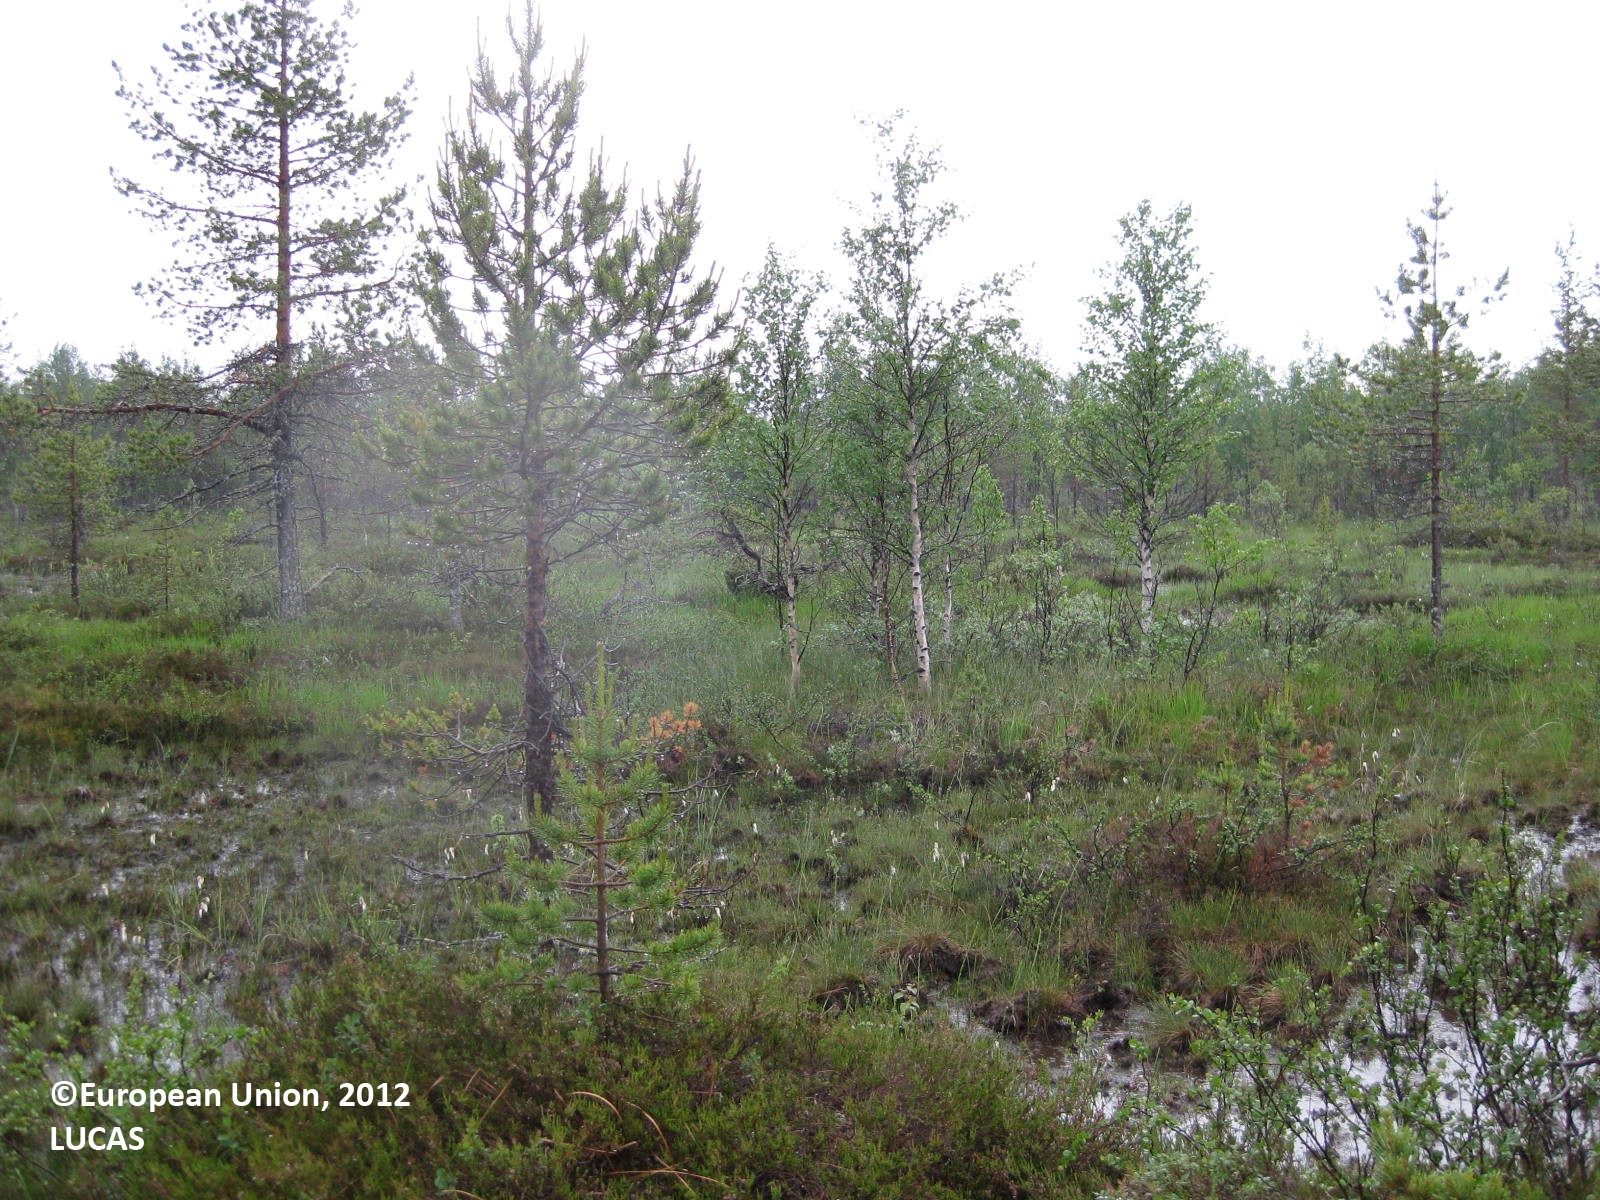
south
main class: Woodland
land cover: Pine dominated mixed woodland
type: boreal forest
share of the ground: 10 - 25 %
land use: Semi-natural and natural areas not in use
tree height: > 5 m
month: July
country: FI
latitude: 65.6702
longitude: 29.4448
